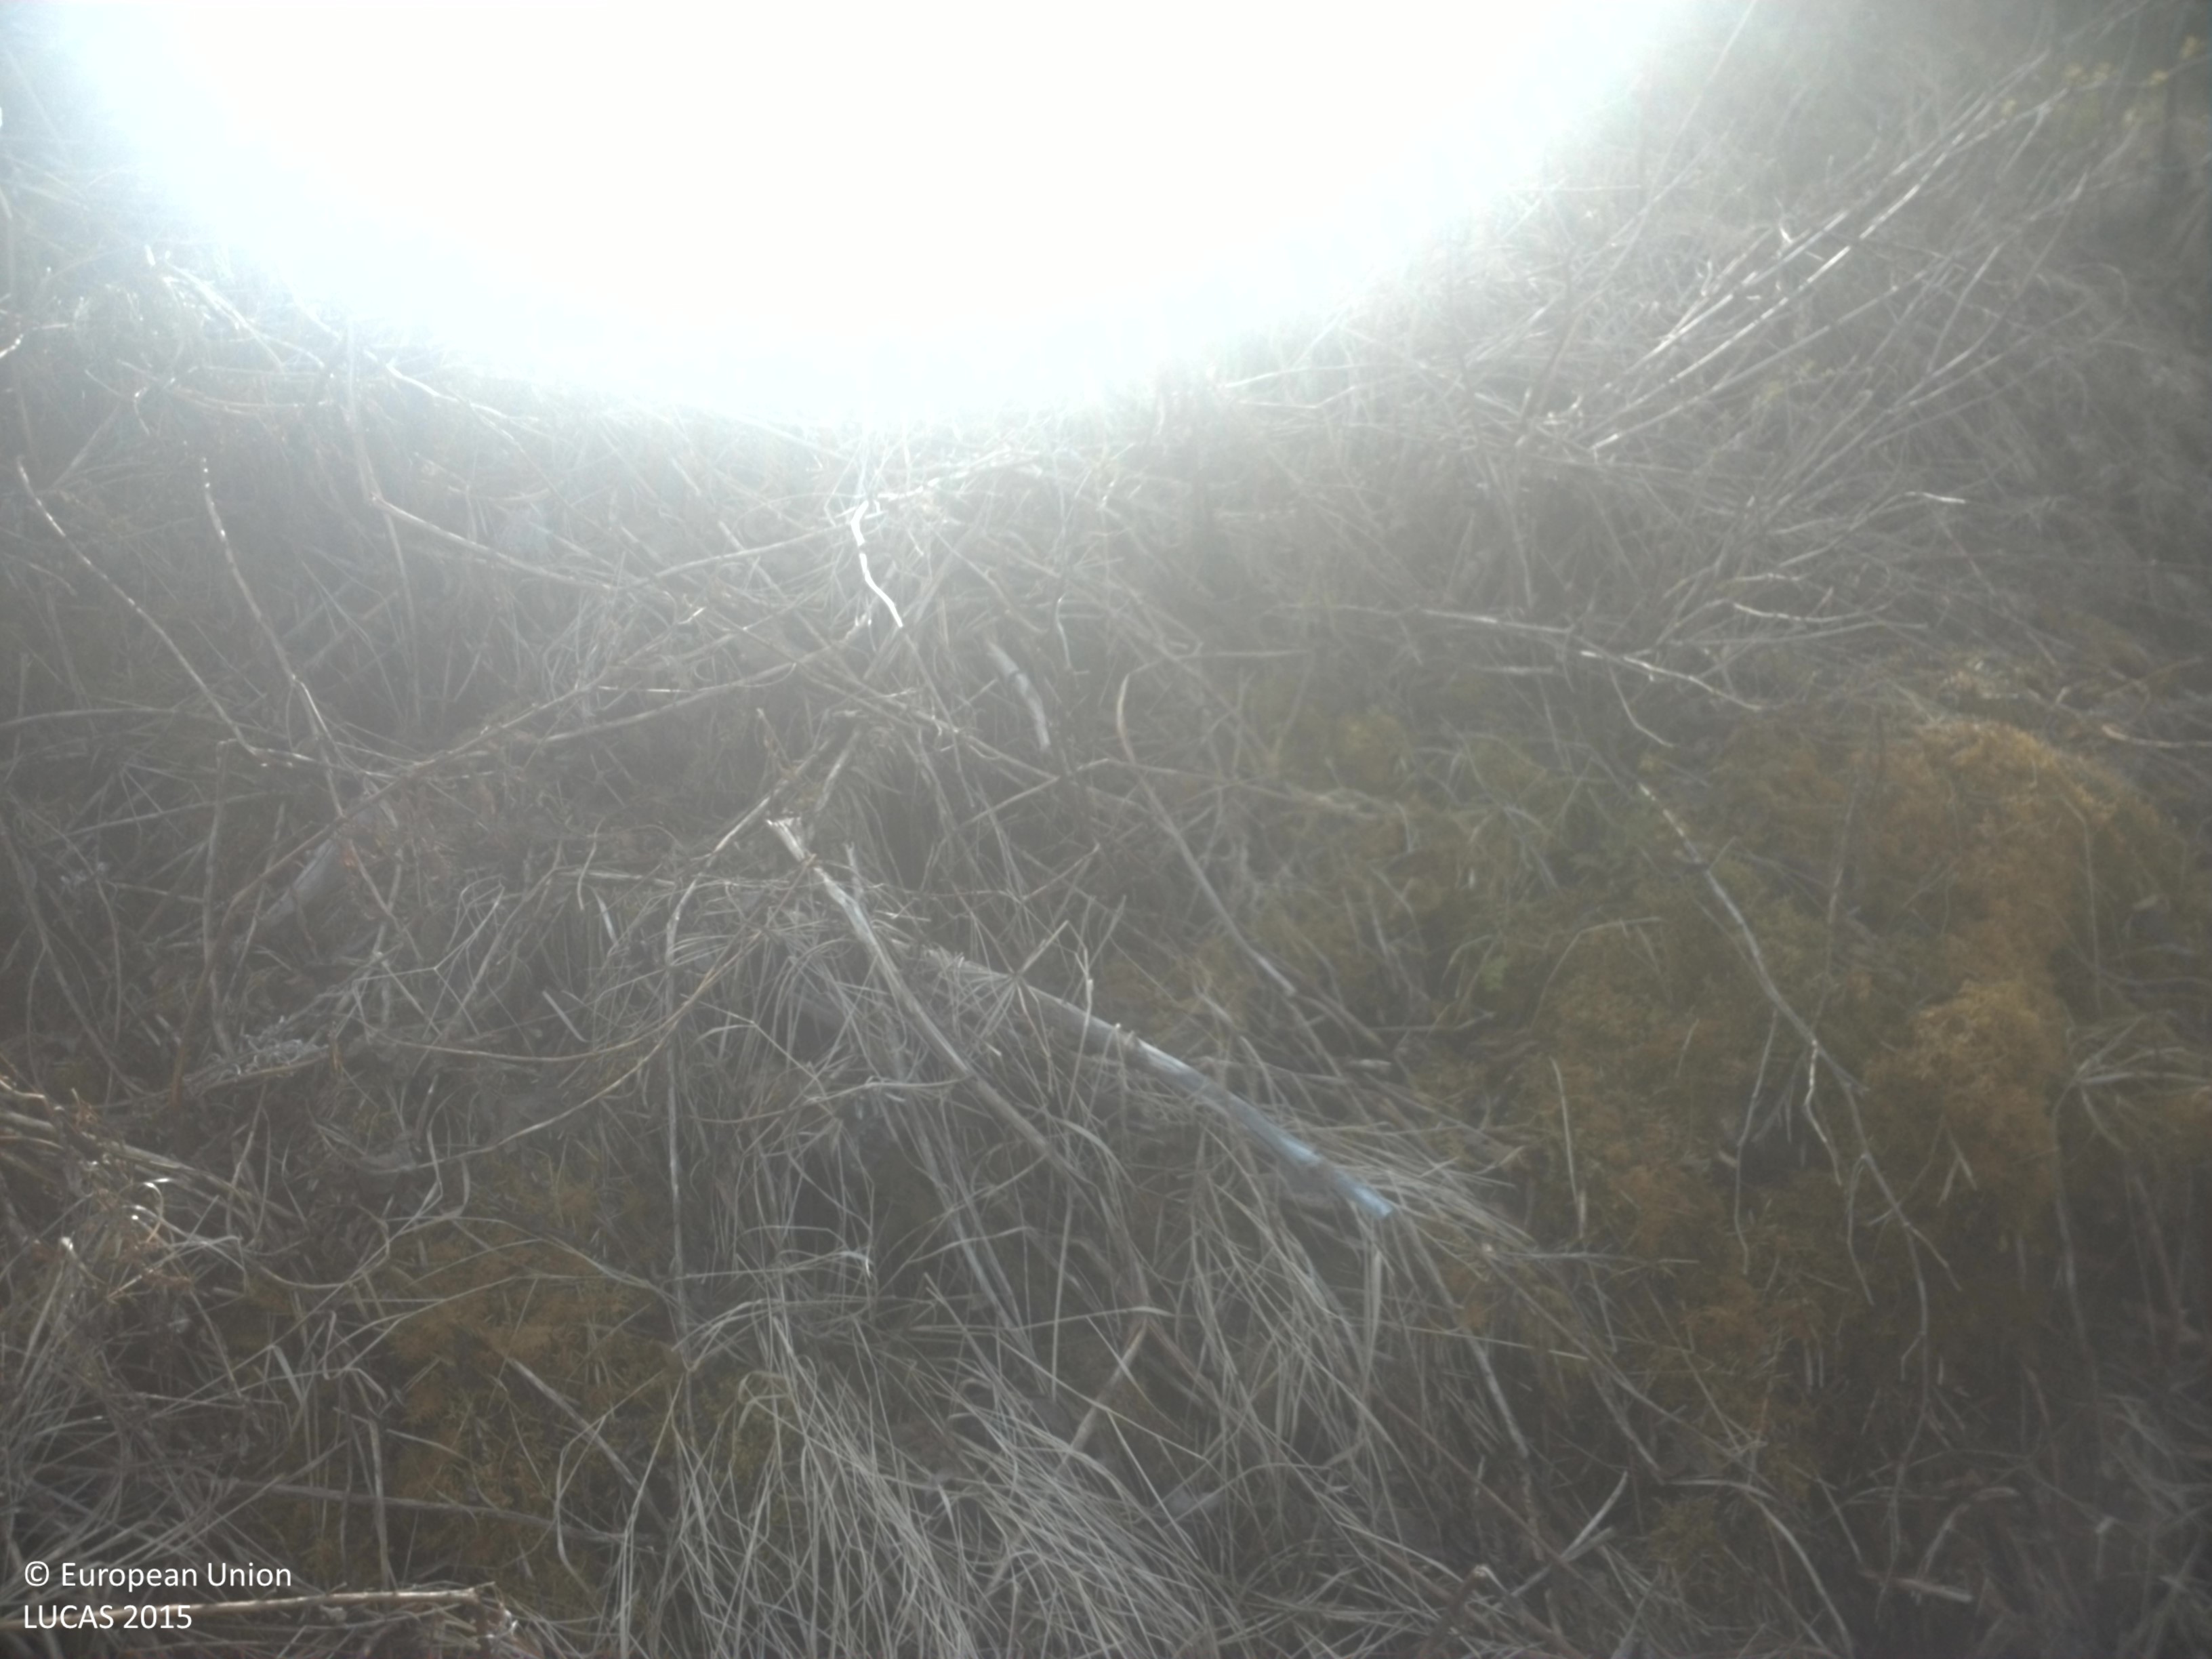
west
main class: Grassland
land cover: Spontaneously vegetated surfaces
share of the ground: > 75 %
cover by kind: herbaceous plants 95 %, shrubs 5 %
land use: Semi-natural and natural areas not in use
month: May
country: SE
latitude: 60.9703
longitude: 13.3327
